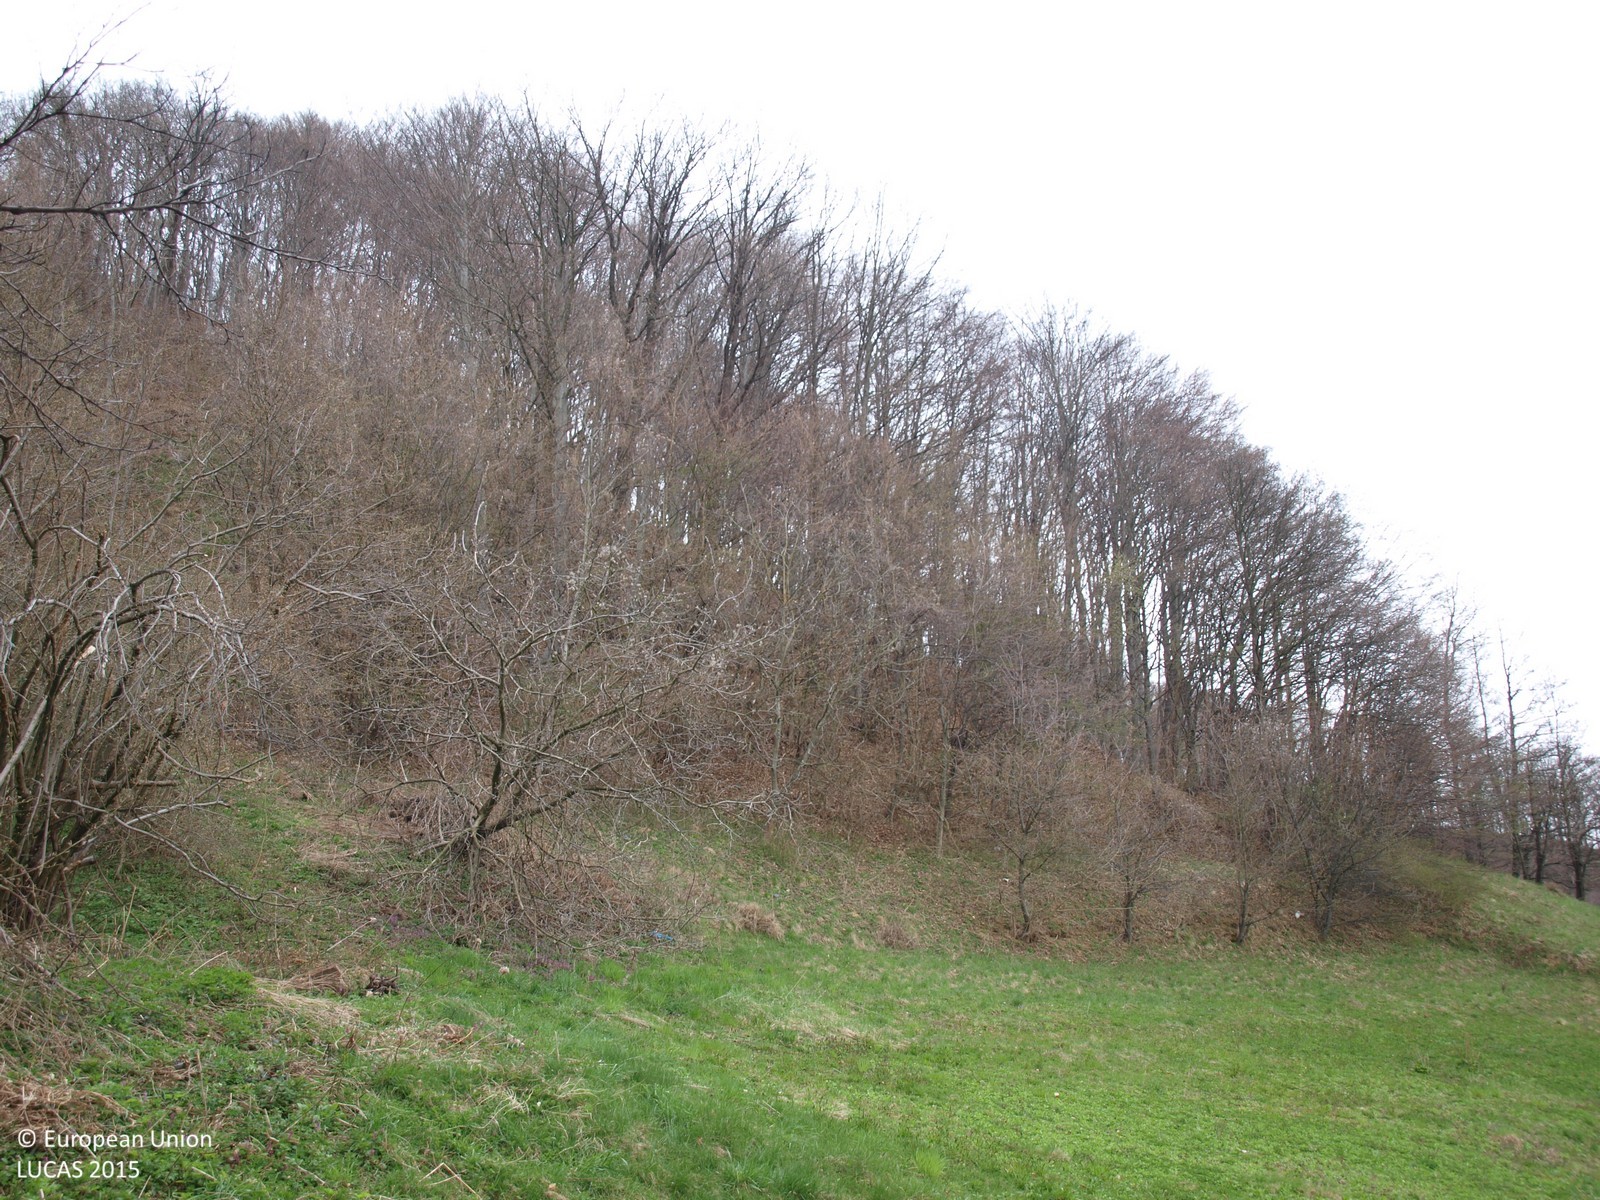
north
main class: Cropland
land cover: Other fruit trees and berries
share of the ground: > 75 %
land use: Agriculture (excluding fallow land and kitchen gardens)
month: April
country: HR
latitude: 46.2178
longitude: 15.6893
